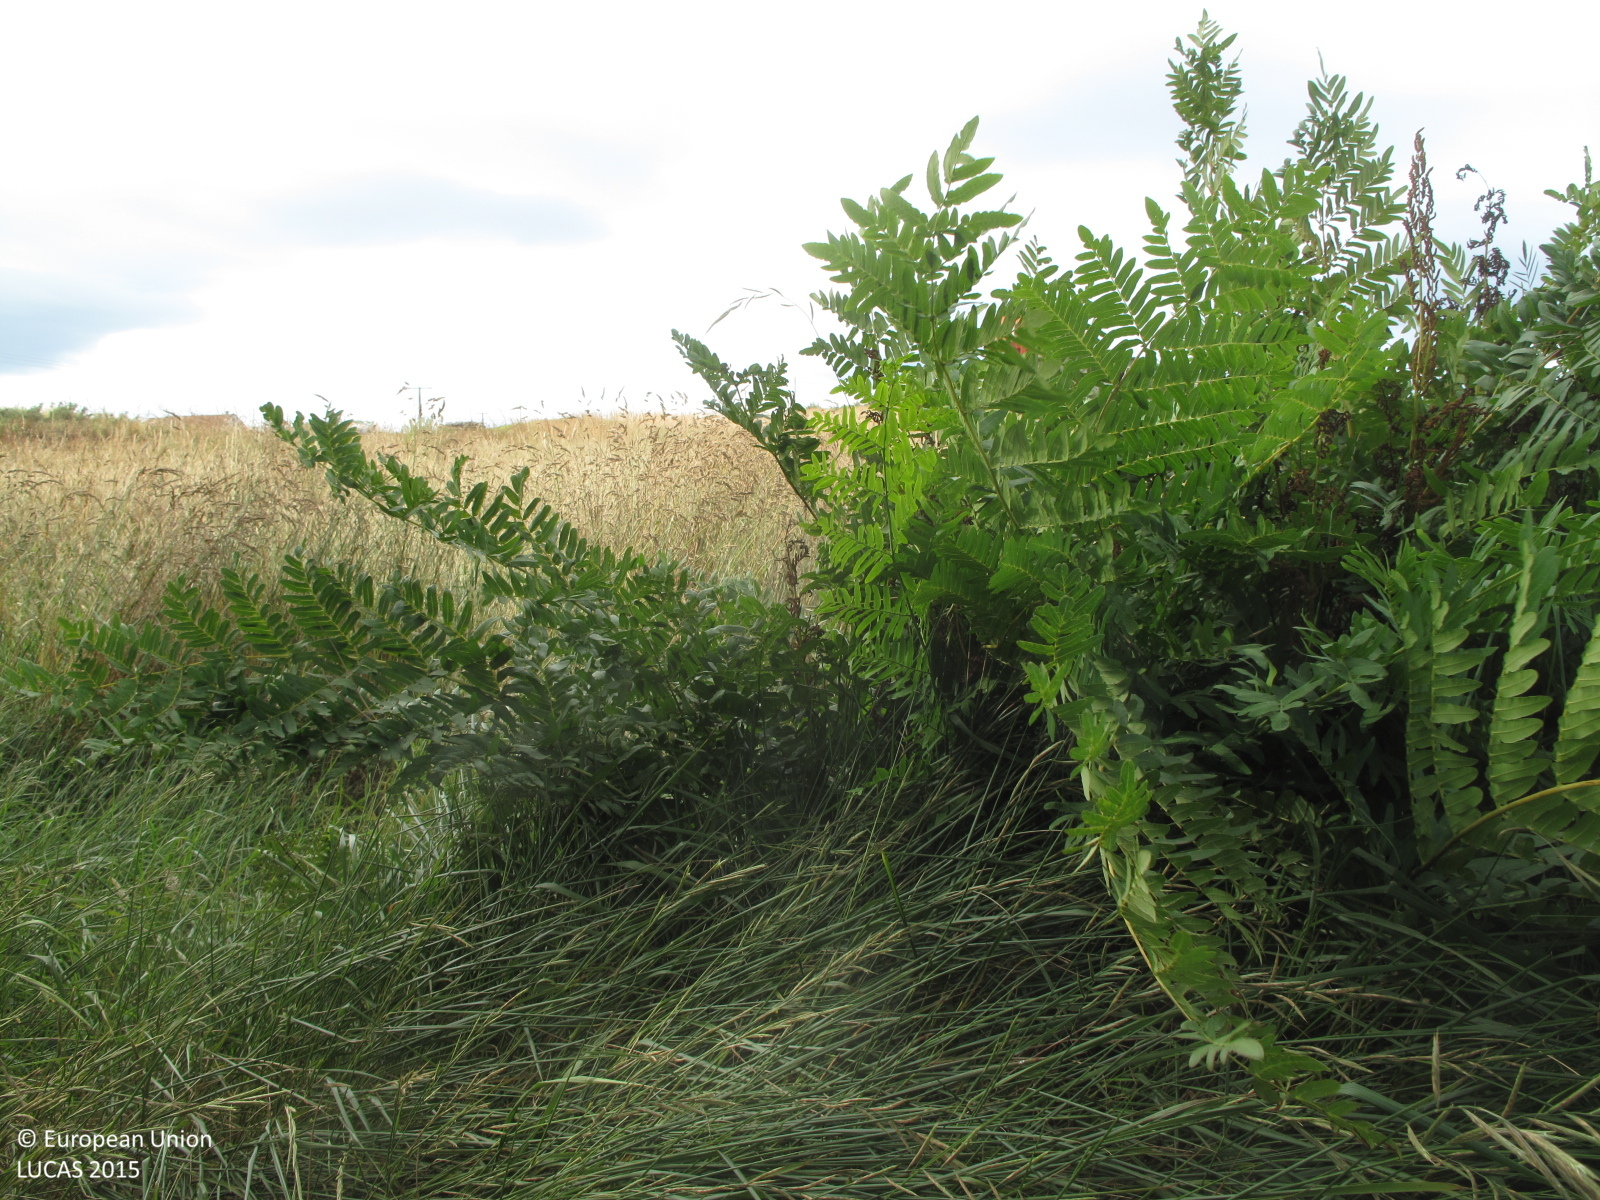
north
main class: Woodland
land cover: Pine dominated mixed woodland
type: exotic forest
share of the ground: 50 - 75 %
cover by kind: coniferous forest trees 40 %, broadleaved forest trees 20 %, shrubs 20 %, herbaceous plants 20 %
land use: Forestry
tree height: > 5 m
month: July
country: ES
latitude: 43.2642
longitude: -8.5781
